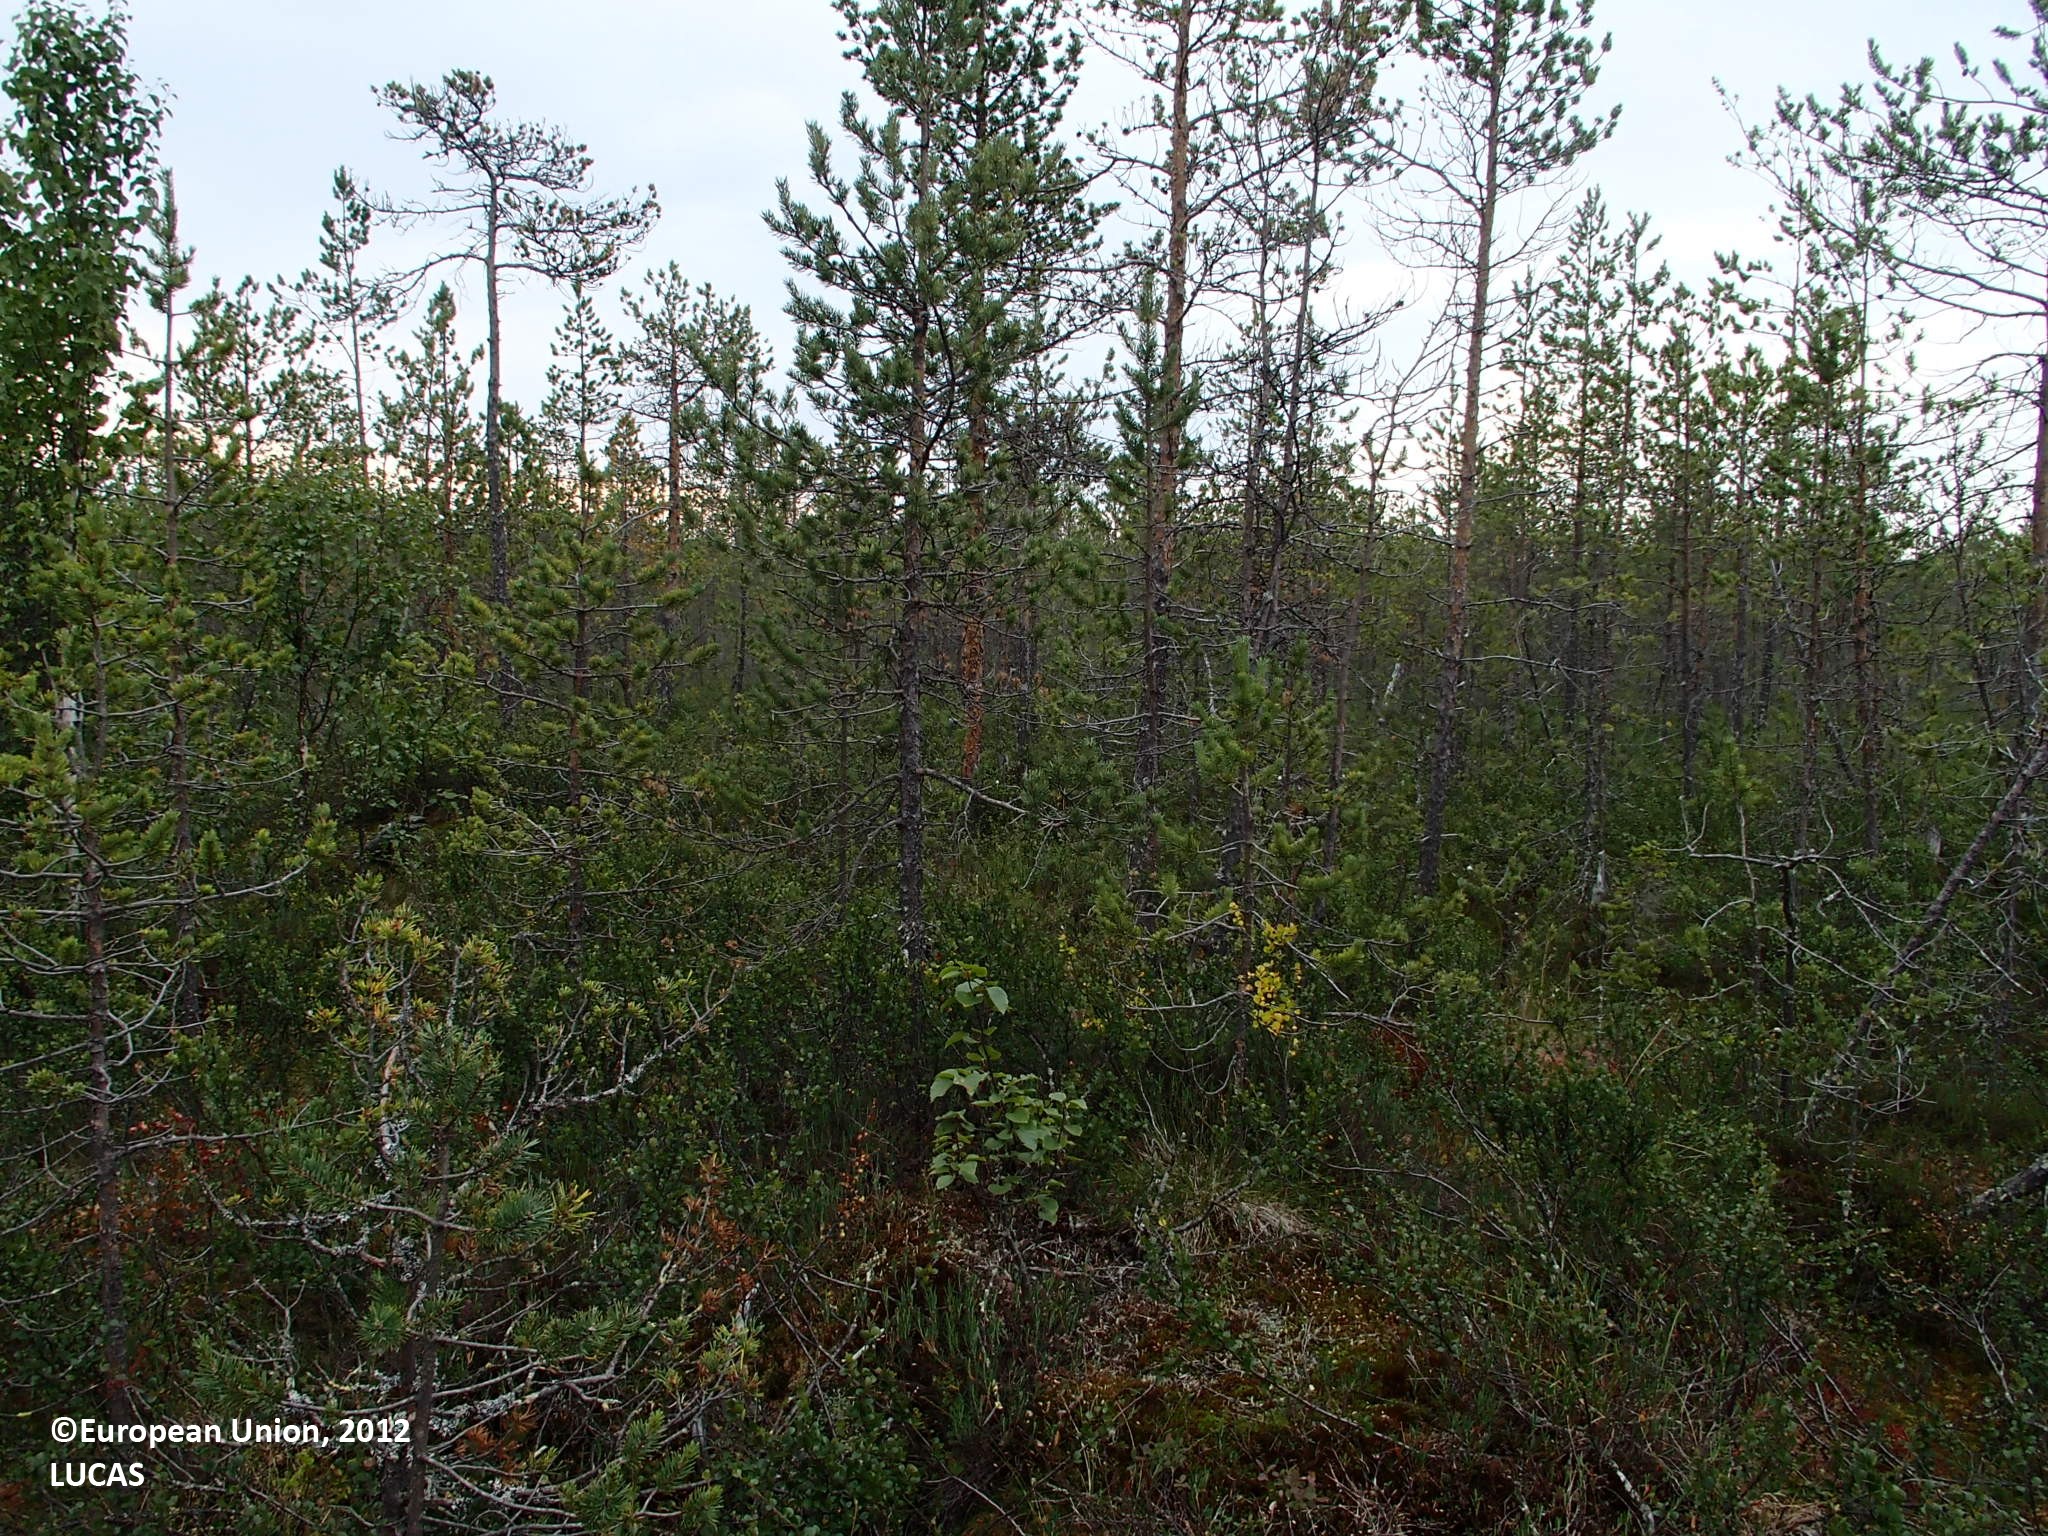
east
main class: Woodland
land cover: Other mixed woodland
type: boreal forest
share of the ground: 50 - 75 %
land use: Forestry
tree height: < 5 m
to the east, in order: Other mixed woodland; Pine dominated coniferous woodland; Ditches and canals; Pine dominated coniferous woodland; Ditches and canals; Pine dominated coniferous woodland; Ditches and canals; Pine dominated coniferous woodland; Other bare soil; Ditches and canals; Other bare soil; Grassland without tree/shrub cover; Ditches and canals; Grassland without tree/shrub cover
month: July
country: FI
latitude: 66.6473
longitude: 25.5028
